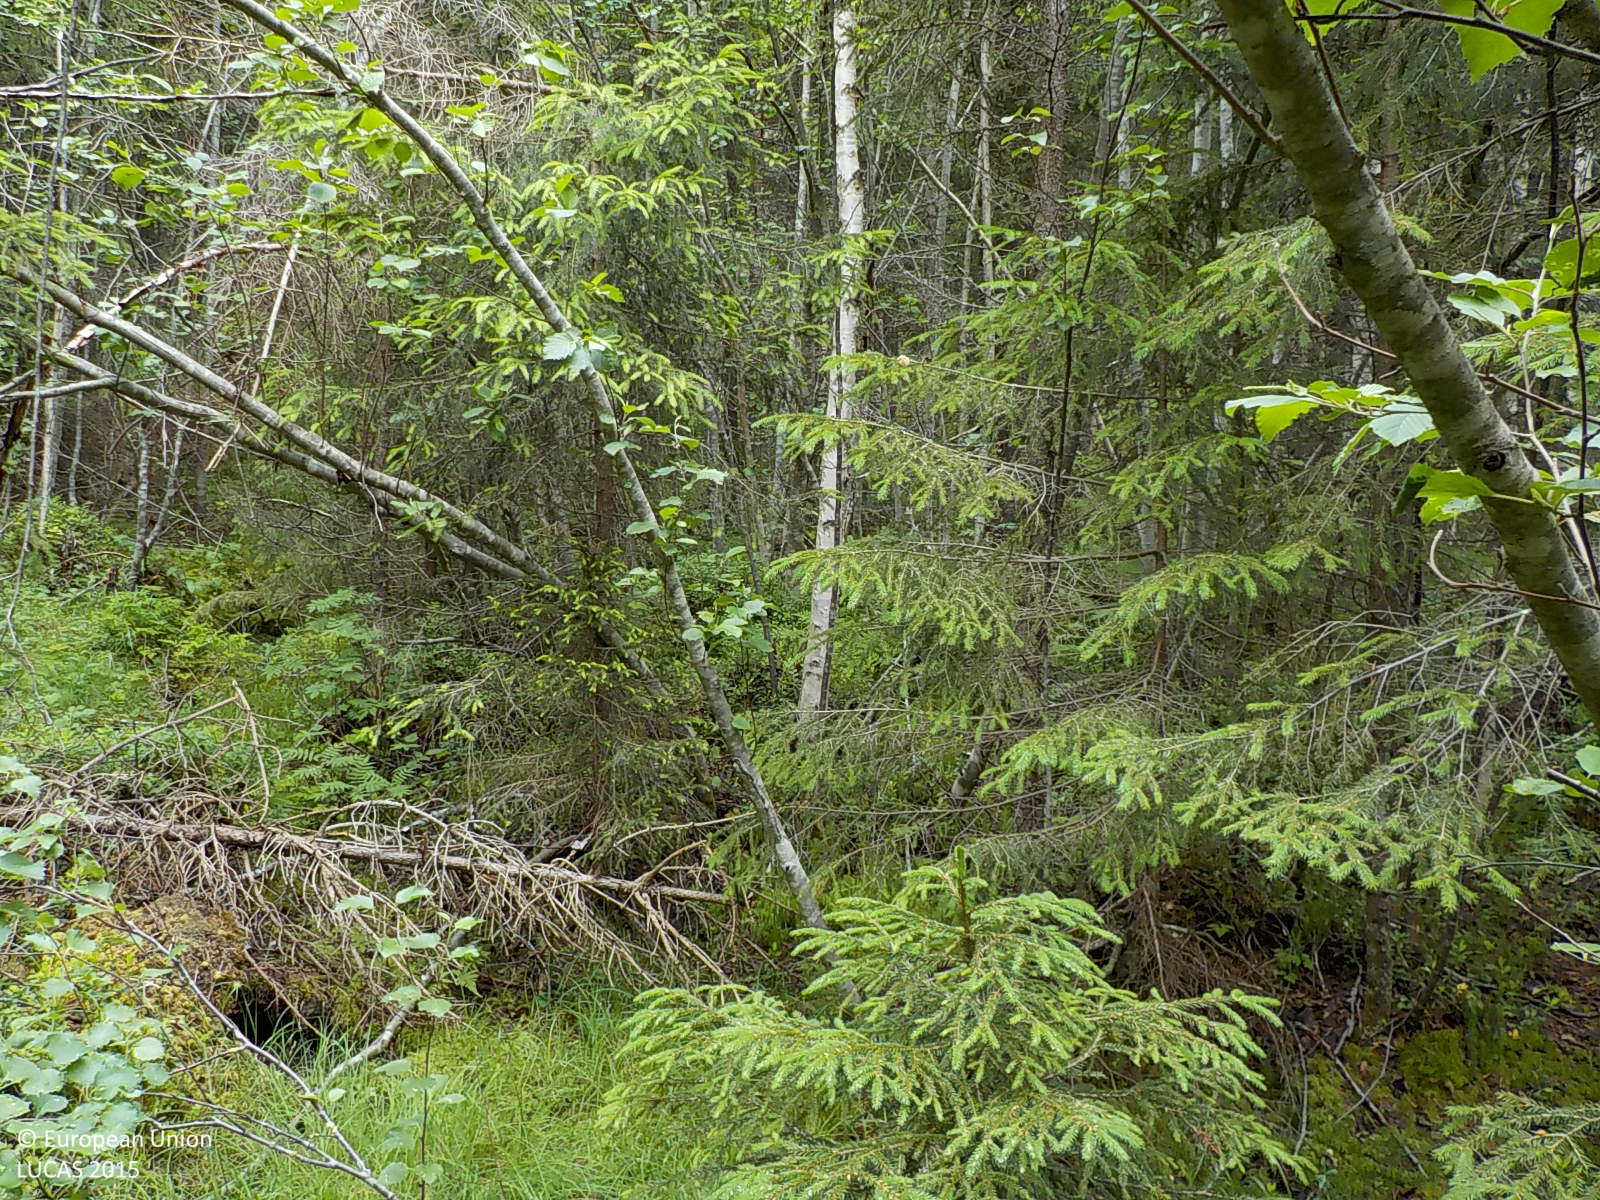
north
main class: Woodland
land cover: Spruce dominated mixed woodland
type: mire and swamp forests
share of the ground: > 75 %
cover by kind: coniferous forest trees 50 %, broadleaved forest trees 40 %, shrubs 10 %
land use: Forestry
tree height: > 5 m
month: July
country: SE
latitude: 63.0869
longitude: 16.9268
